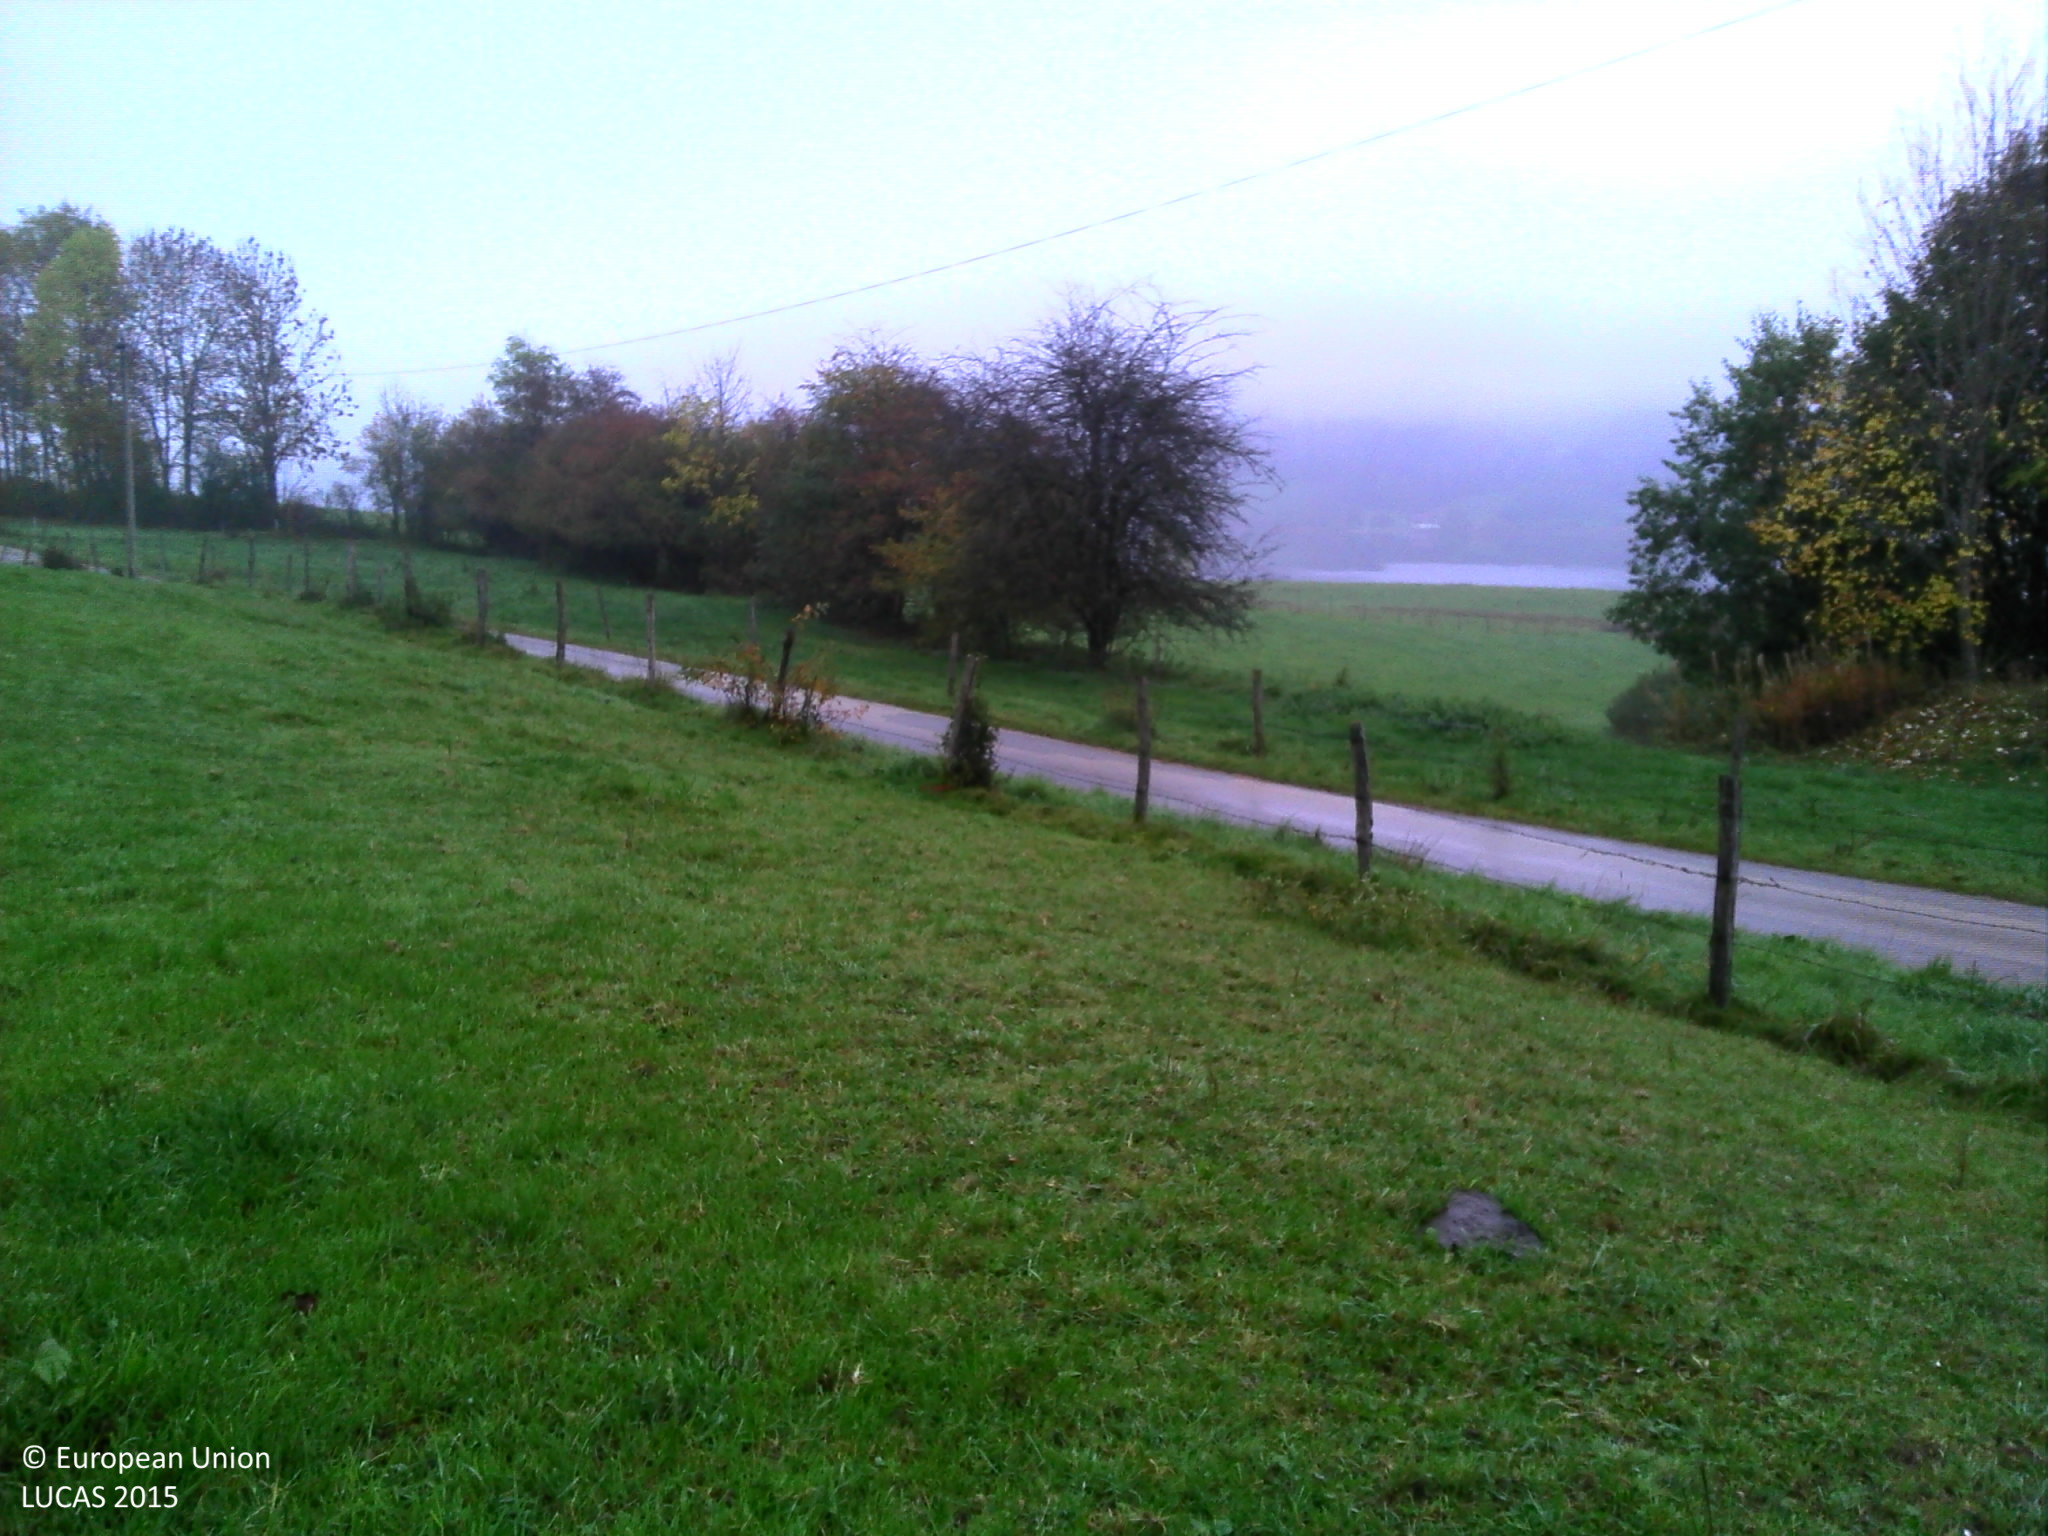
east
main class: Grassland
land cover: Grassland without tree/shrub cover
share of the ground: > 75 %
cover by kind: herbaceous plants 100 %
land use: Agriculture (excluding fallow land and kitchen gardens)
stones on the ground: < 10 %
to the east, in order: Grassland without tree/shrub cover; Electric lines; Fences; Grass margins; Paved roads, cycling and walking lanes; Fences; Grassland without tree/shrub cover; Broadleaved woodland; Grassland without tree/shrub cover; Fences; Grassland without tree/shrub cover
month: October
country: FR
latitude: 46.8098
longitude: 6.2939
